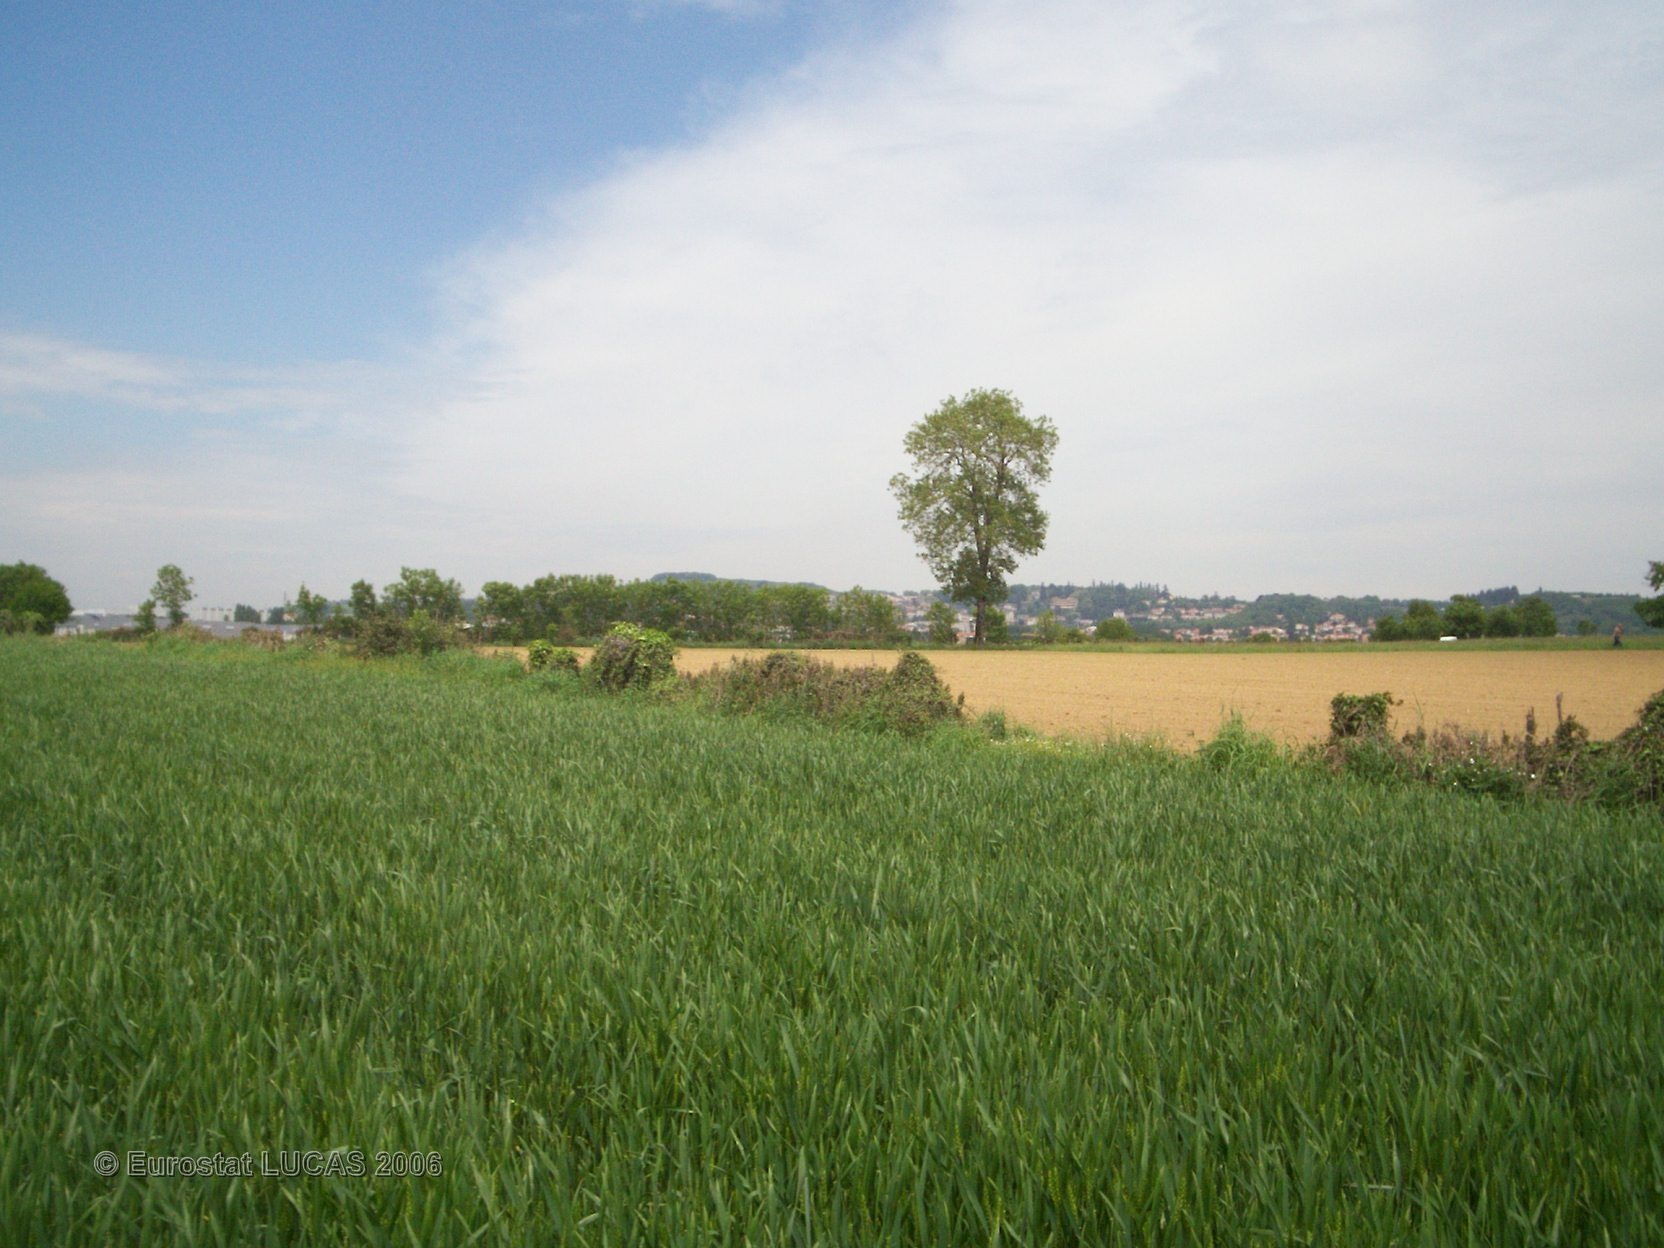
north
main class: Cropland
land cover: Barley
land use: Agriculture (excluding fallow land and kitchen gardens)
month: May
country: FR
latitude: 46.7620
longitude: -0.8332
